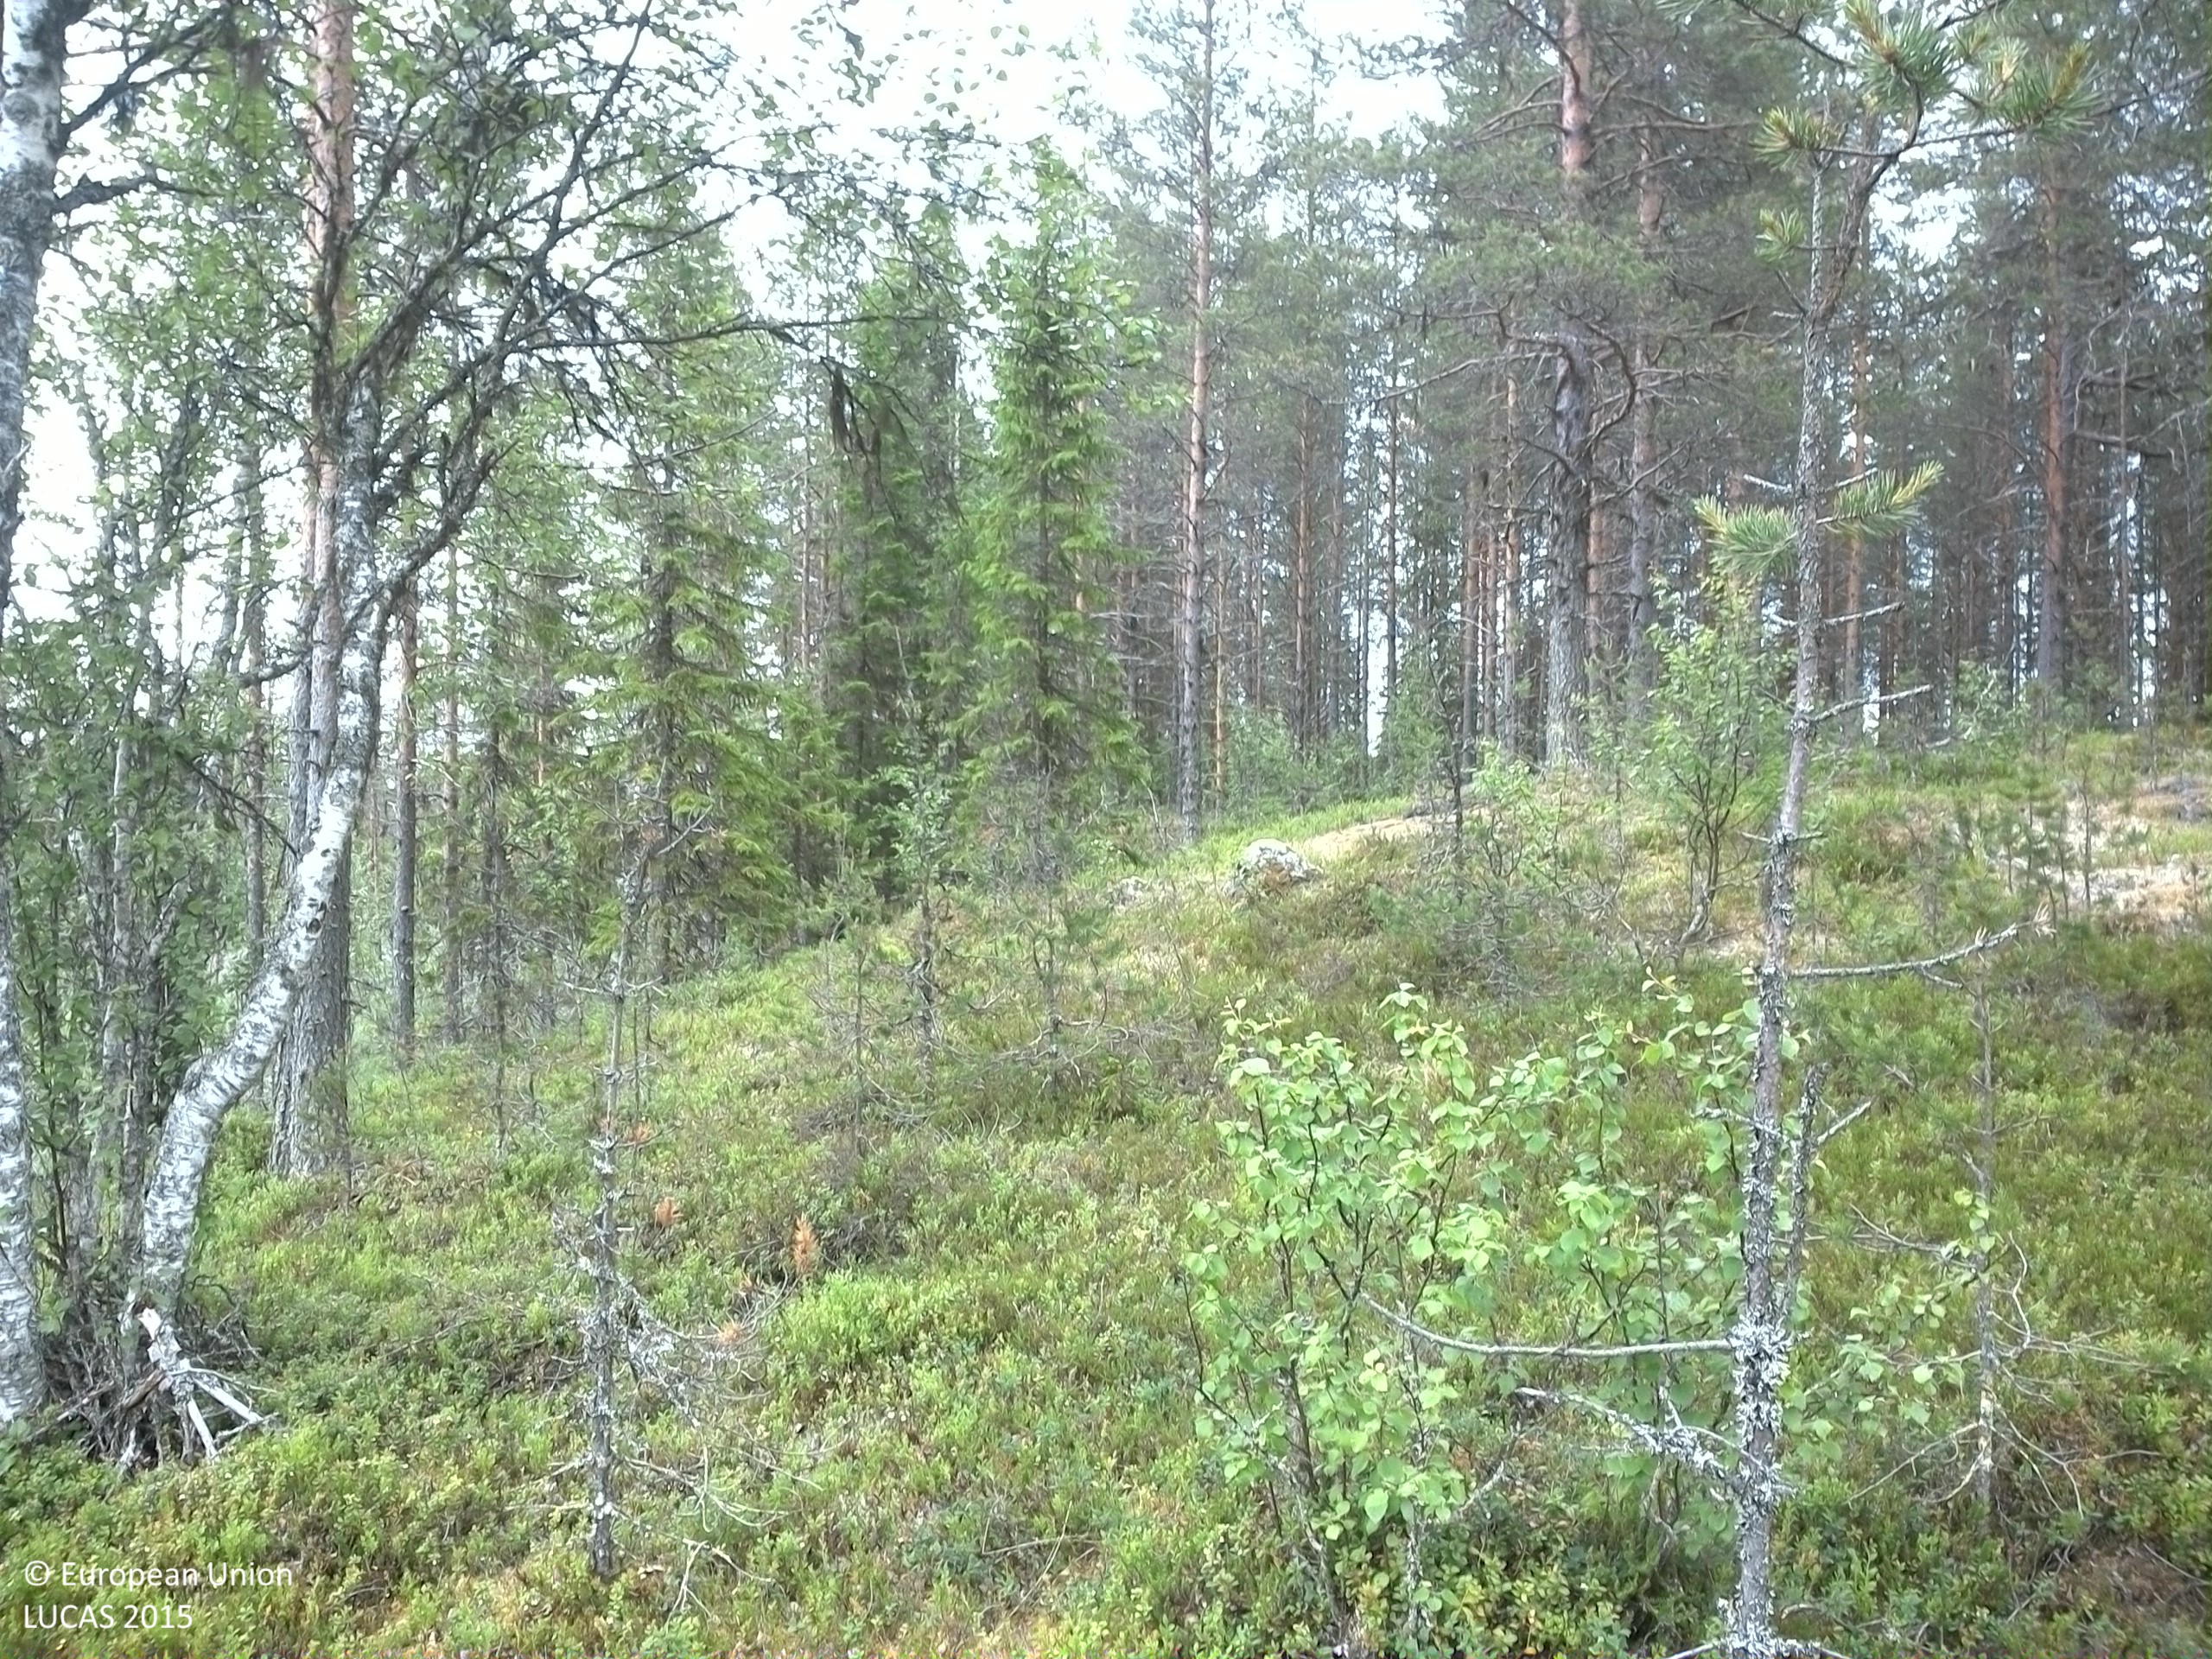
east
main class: Woodland
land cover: Pine dominated coniferous woodland
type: boreal forest
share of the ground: 25 - 50 %
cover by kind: shrubs 50 %, coniferous forest trees 35 %, lichens and mosses 10 %, broadleaved forest trees 5 %
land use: Forestry
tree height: > 5 m
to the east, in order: Pine dominated coniferous woodland; Spruce dominated mixed woodland; Peatbogs
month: July
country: SE
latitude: 63.6080
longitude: 17.4137
